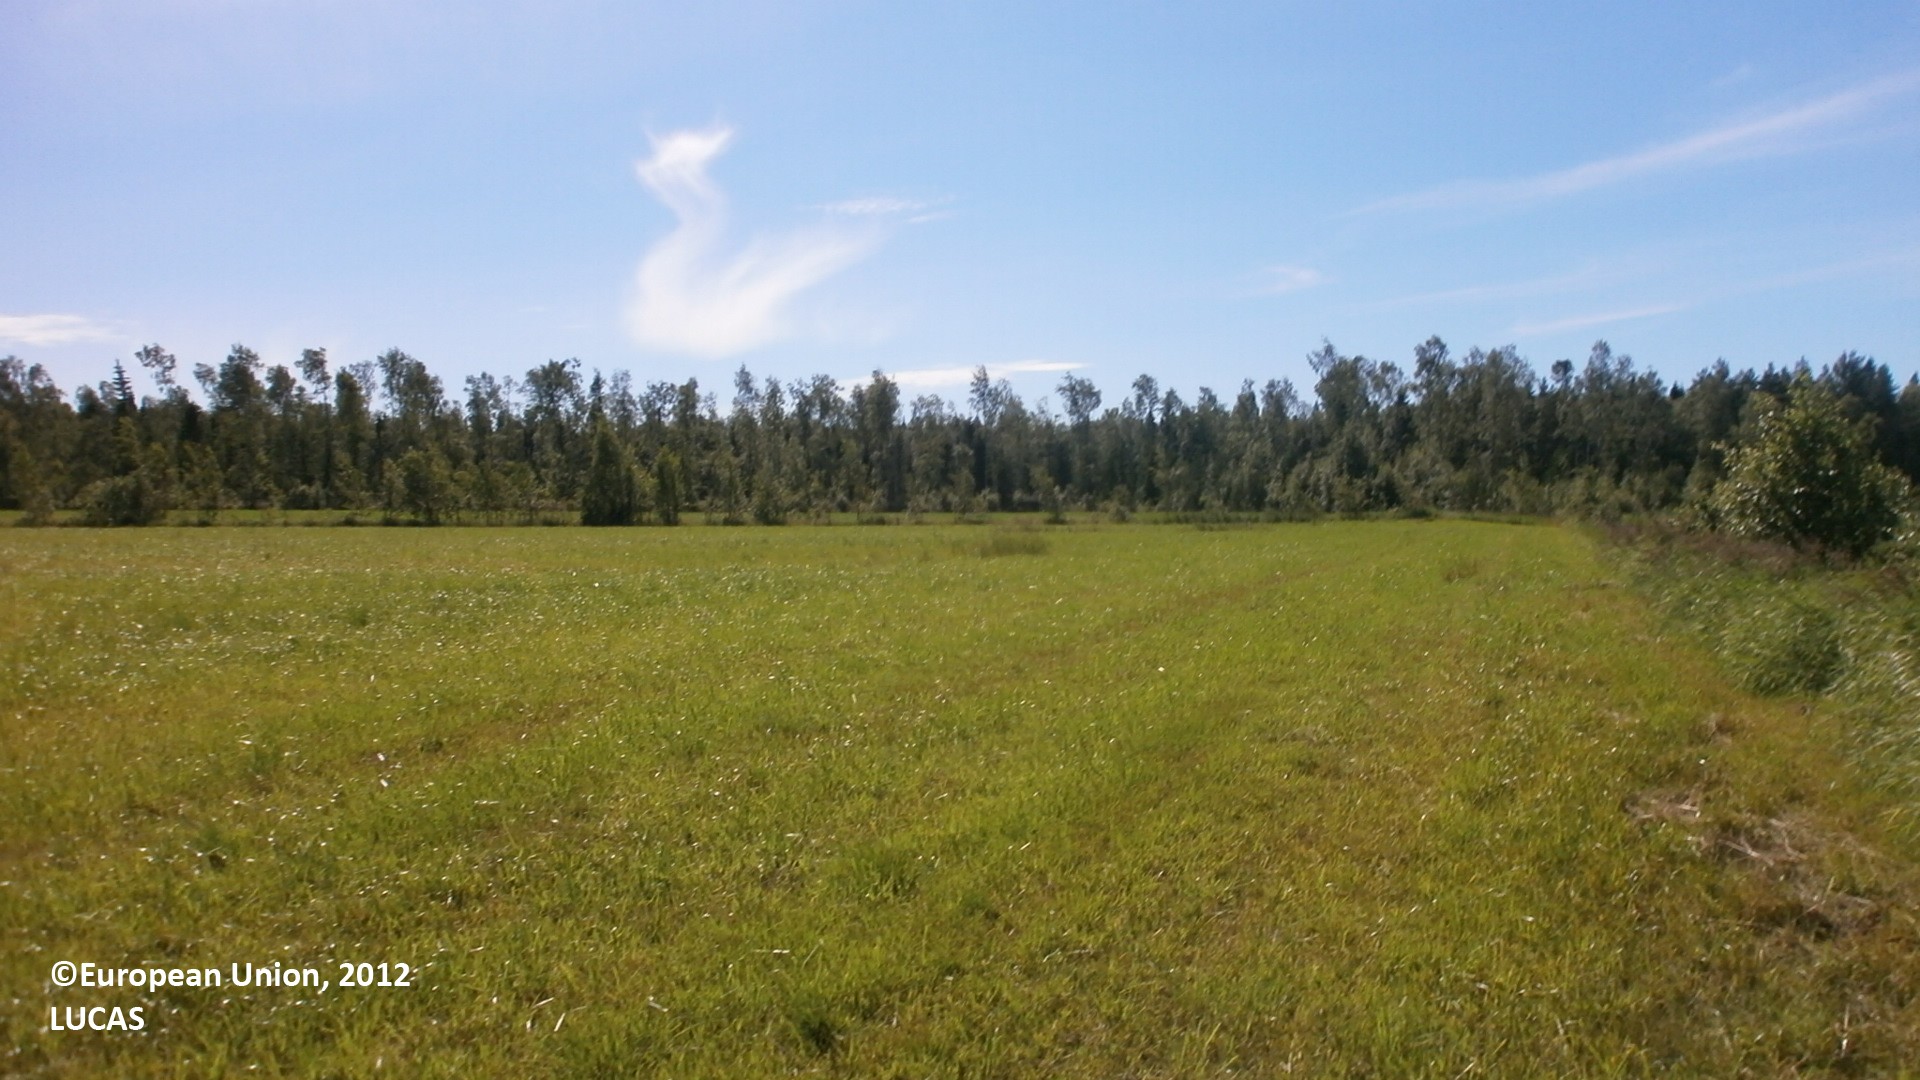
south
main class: Cropland
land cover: Temporary grasslands
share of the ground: > 75 %
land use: Agriculture (excluding fallow land and kitchen gardens)
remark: Harvested field
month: July
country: FI
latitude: 64.3763
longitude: 24.0516
